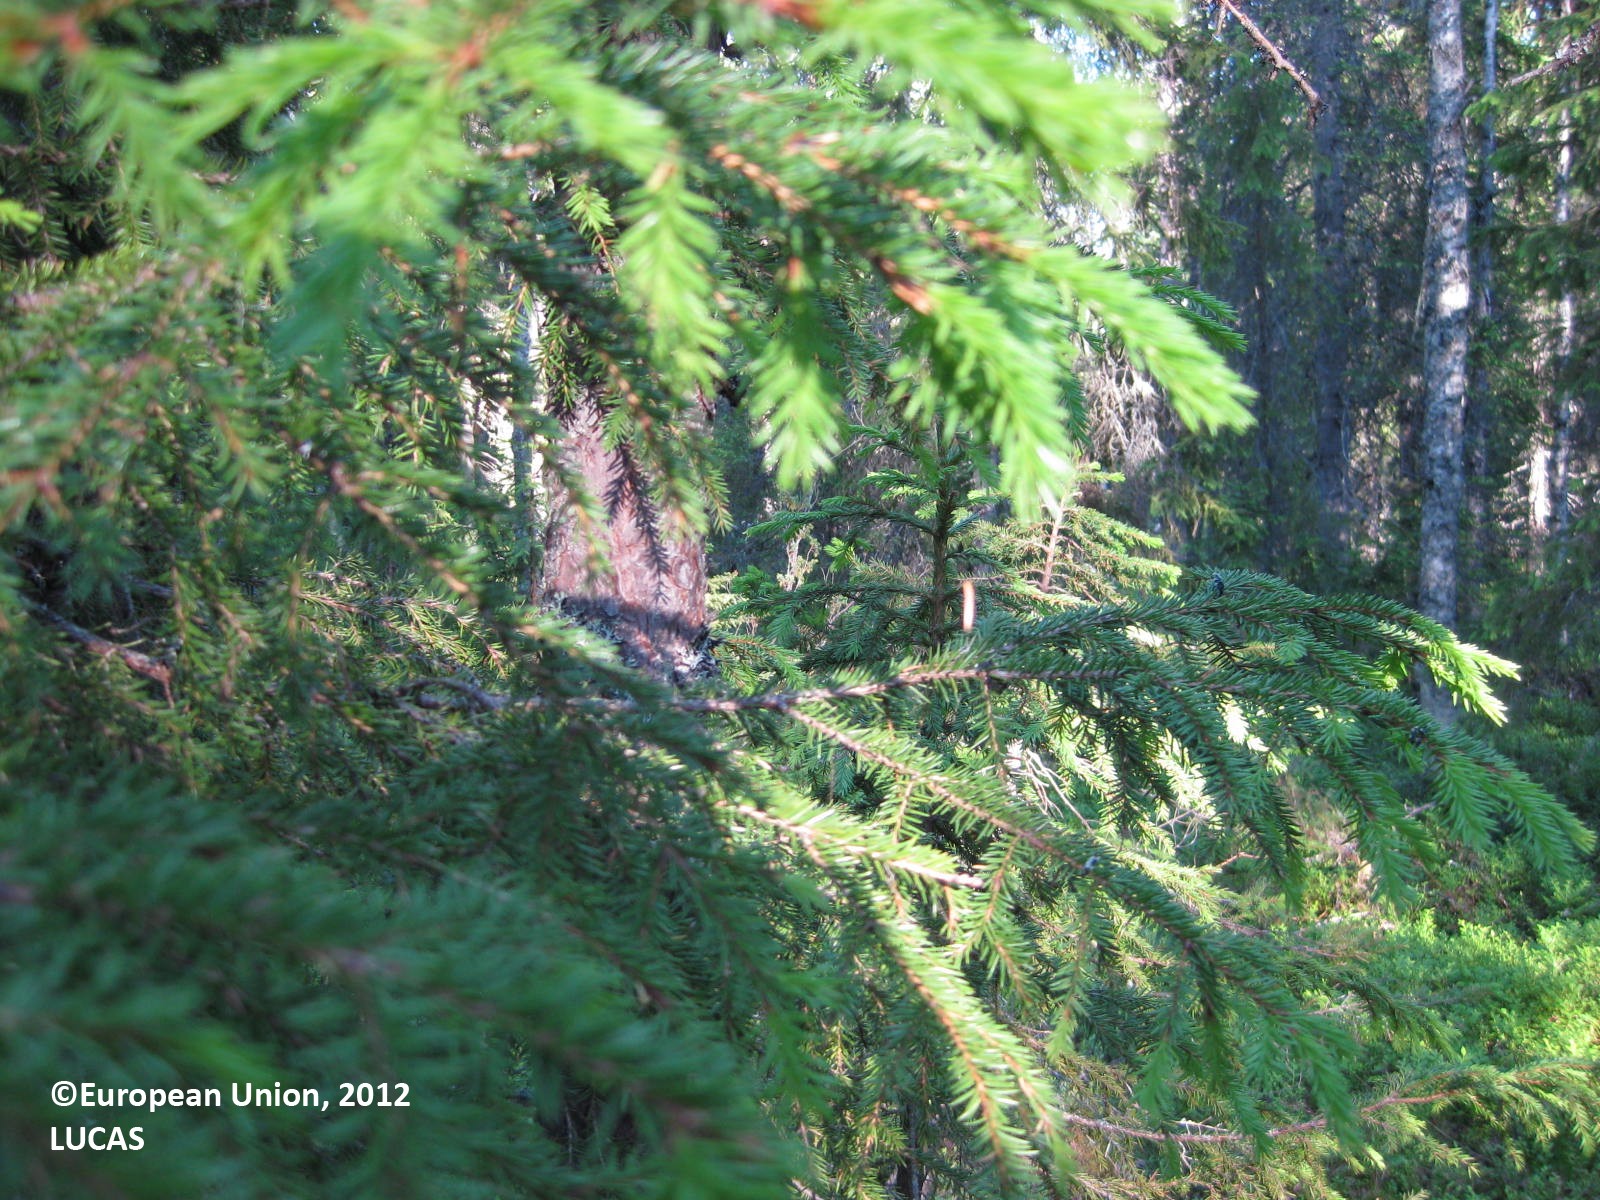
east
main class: Woodland
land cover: Spruce dominated coniferous woodland
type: boreal forest
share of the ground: > 75 %
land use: Forestry
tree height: > 5 m
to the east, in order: Spruce dominated coniferous woodland; Other coniferous woodland; Spruce dominated coniferous woodland; Spruce dominated mixed woodland; Spruce dominated coniferous woodland; Spruce dominated mixed woodland
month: June
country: FI
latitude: 65.2657
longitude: 28.2562
